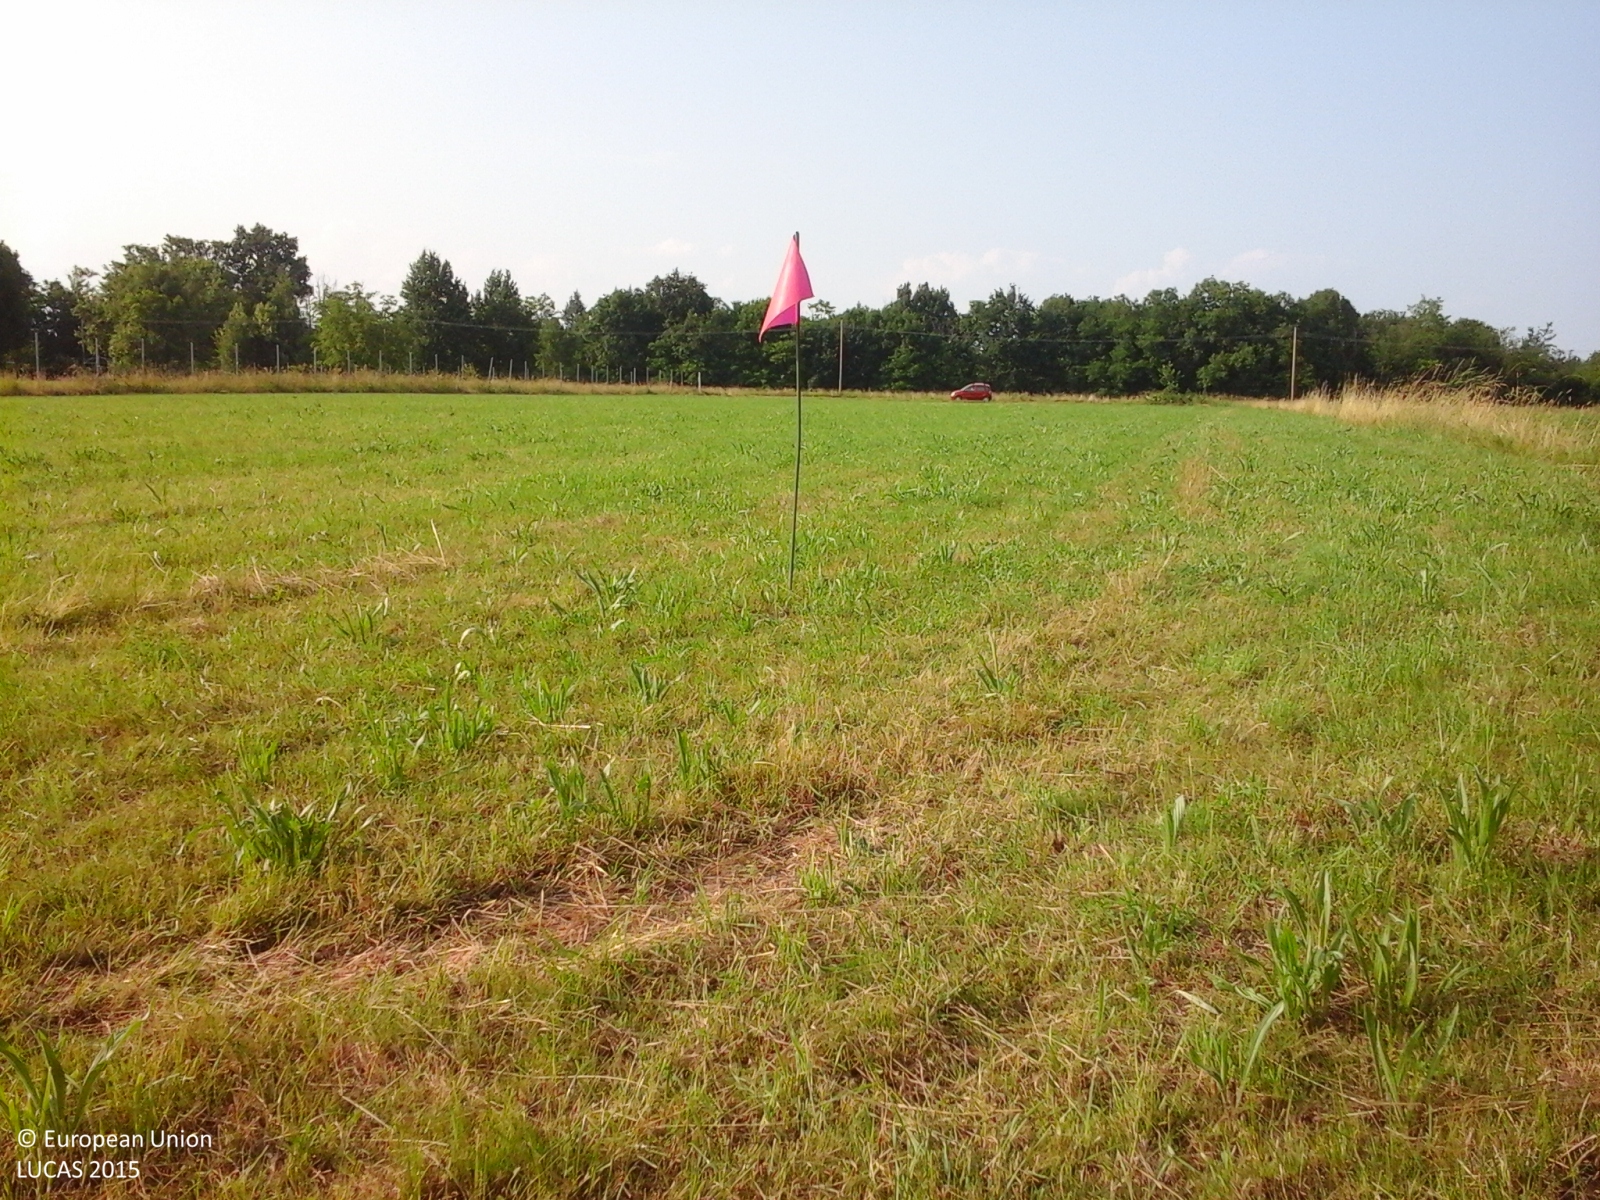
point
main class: Grassland
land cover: Grassland without tree/shrub cover
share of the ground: > 75 %
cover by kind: herbaceous plants 100 %
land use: Agriculture (excluding fallow land and kitchen gardens)
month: June
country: IT
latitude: 45.2100
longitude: 7.7502
